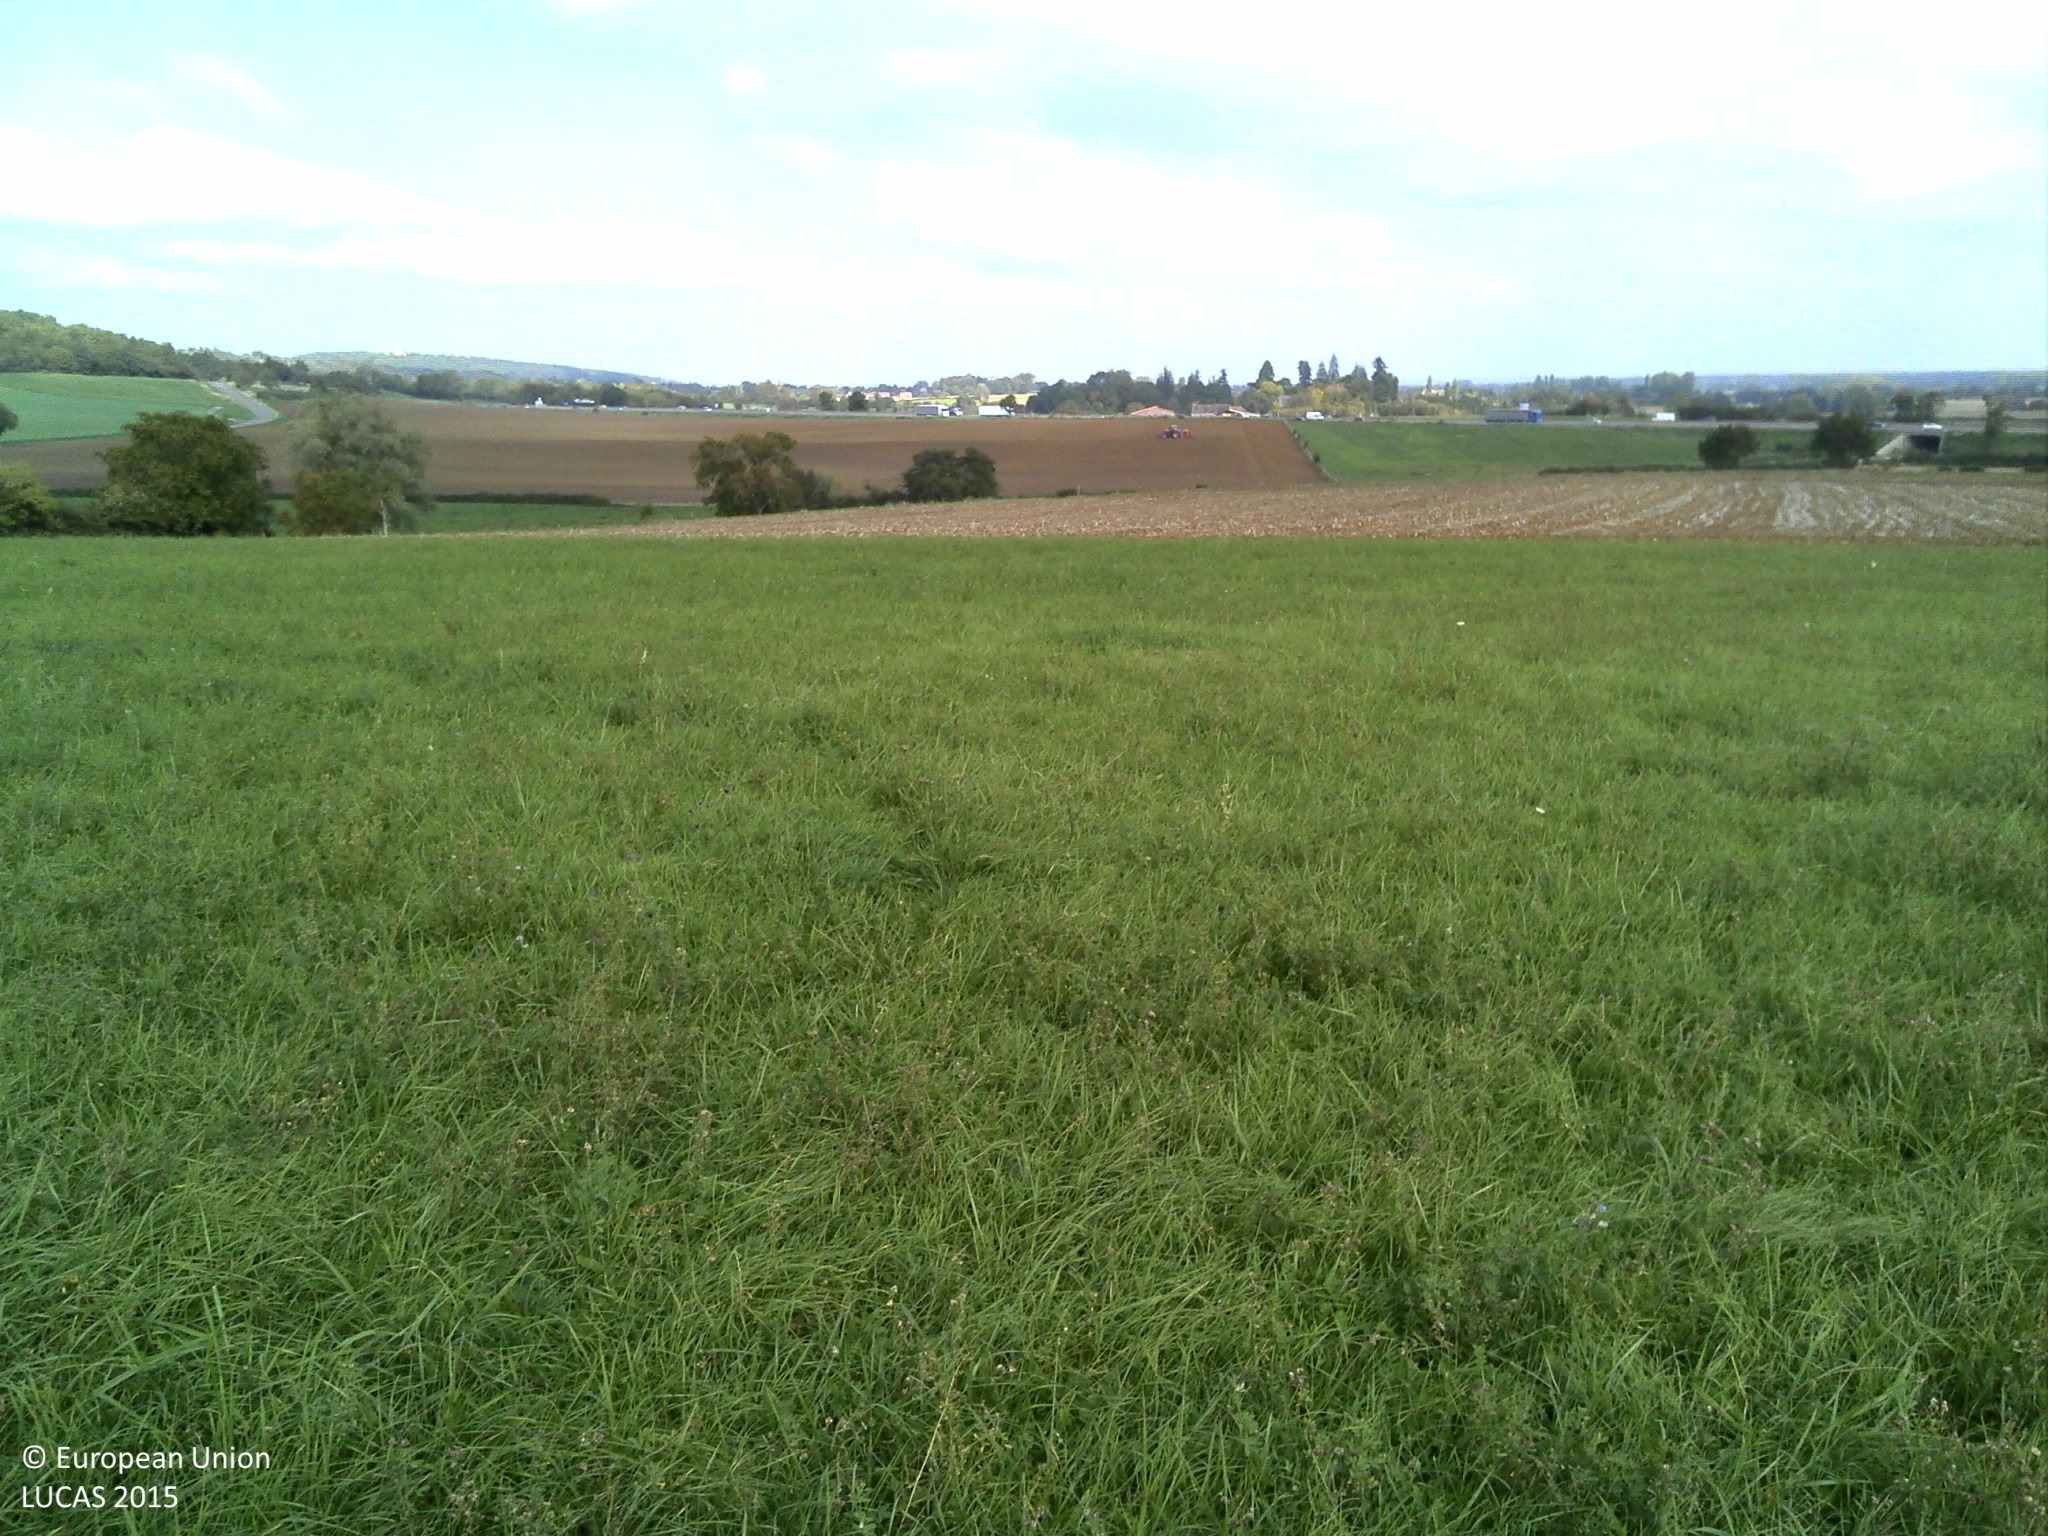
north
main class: Grassland
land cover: Grassland without tree/shrub cover
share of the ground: > 75 %
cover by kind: herbaceous plants 100 %
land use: Agriculture (excluding fallow land and kitchen gardens)
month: October
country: FR
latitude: 46.6071
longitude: 4.8707
